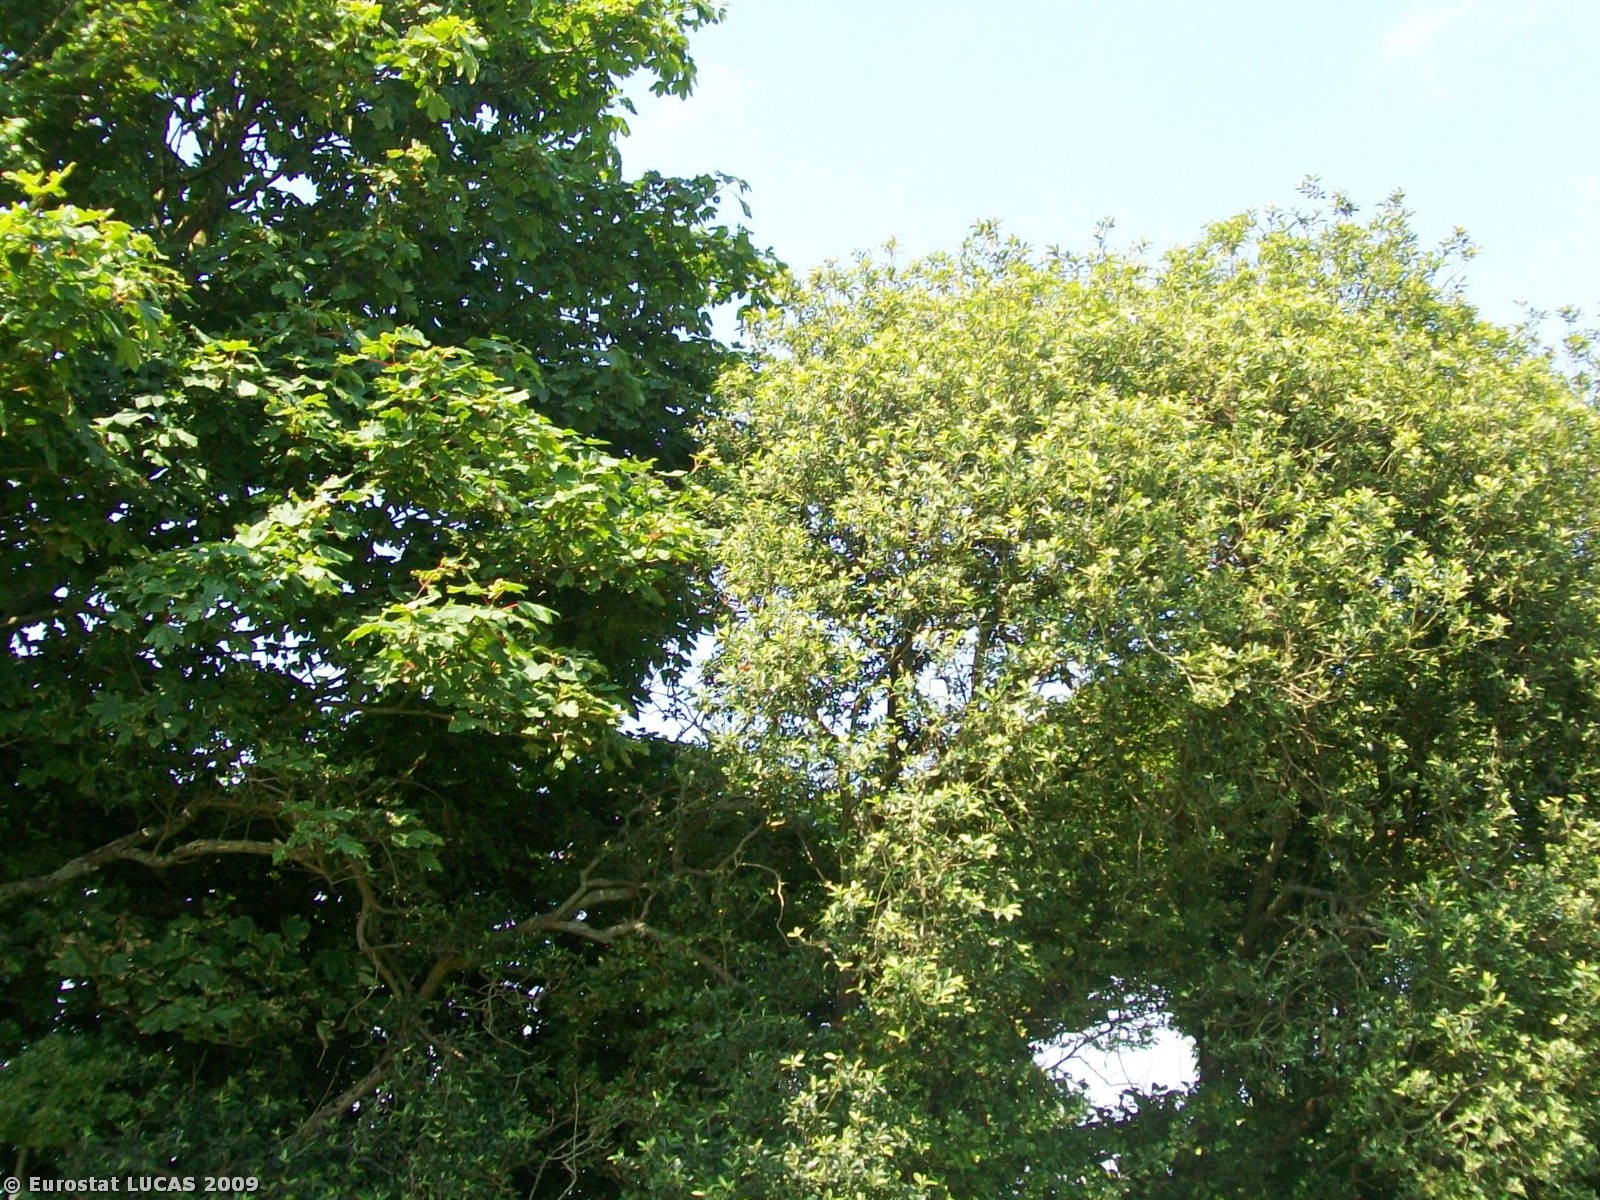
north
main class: Grassland
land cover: Grassland without tree/shrub cover
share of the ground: > 75 %
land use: Agriculture (excluding fallow land and kitchen gardens)
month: June
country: GB
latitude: 50.0803
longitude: -5.1411
